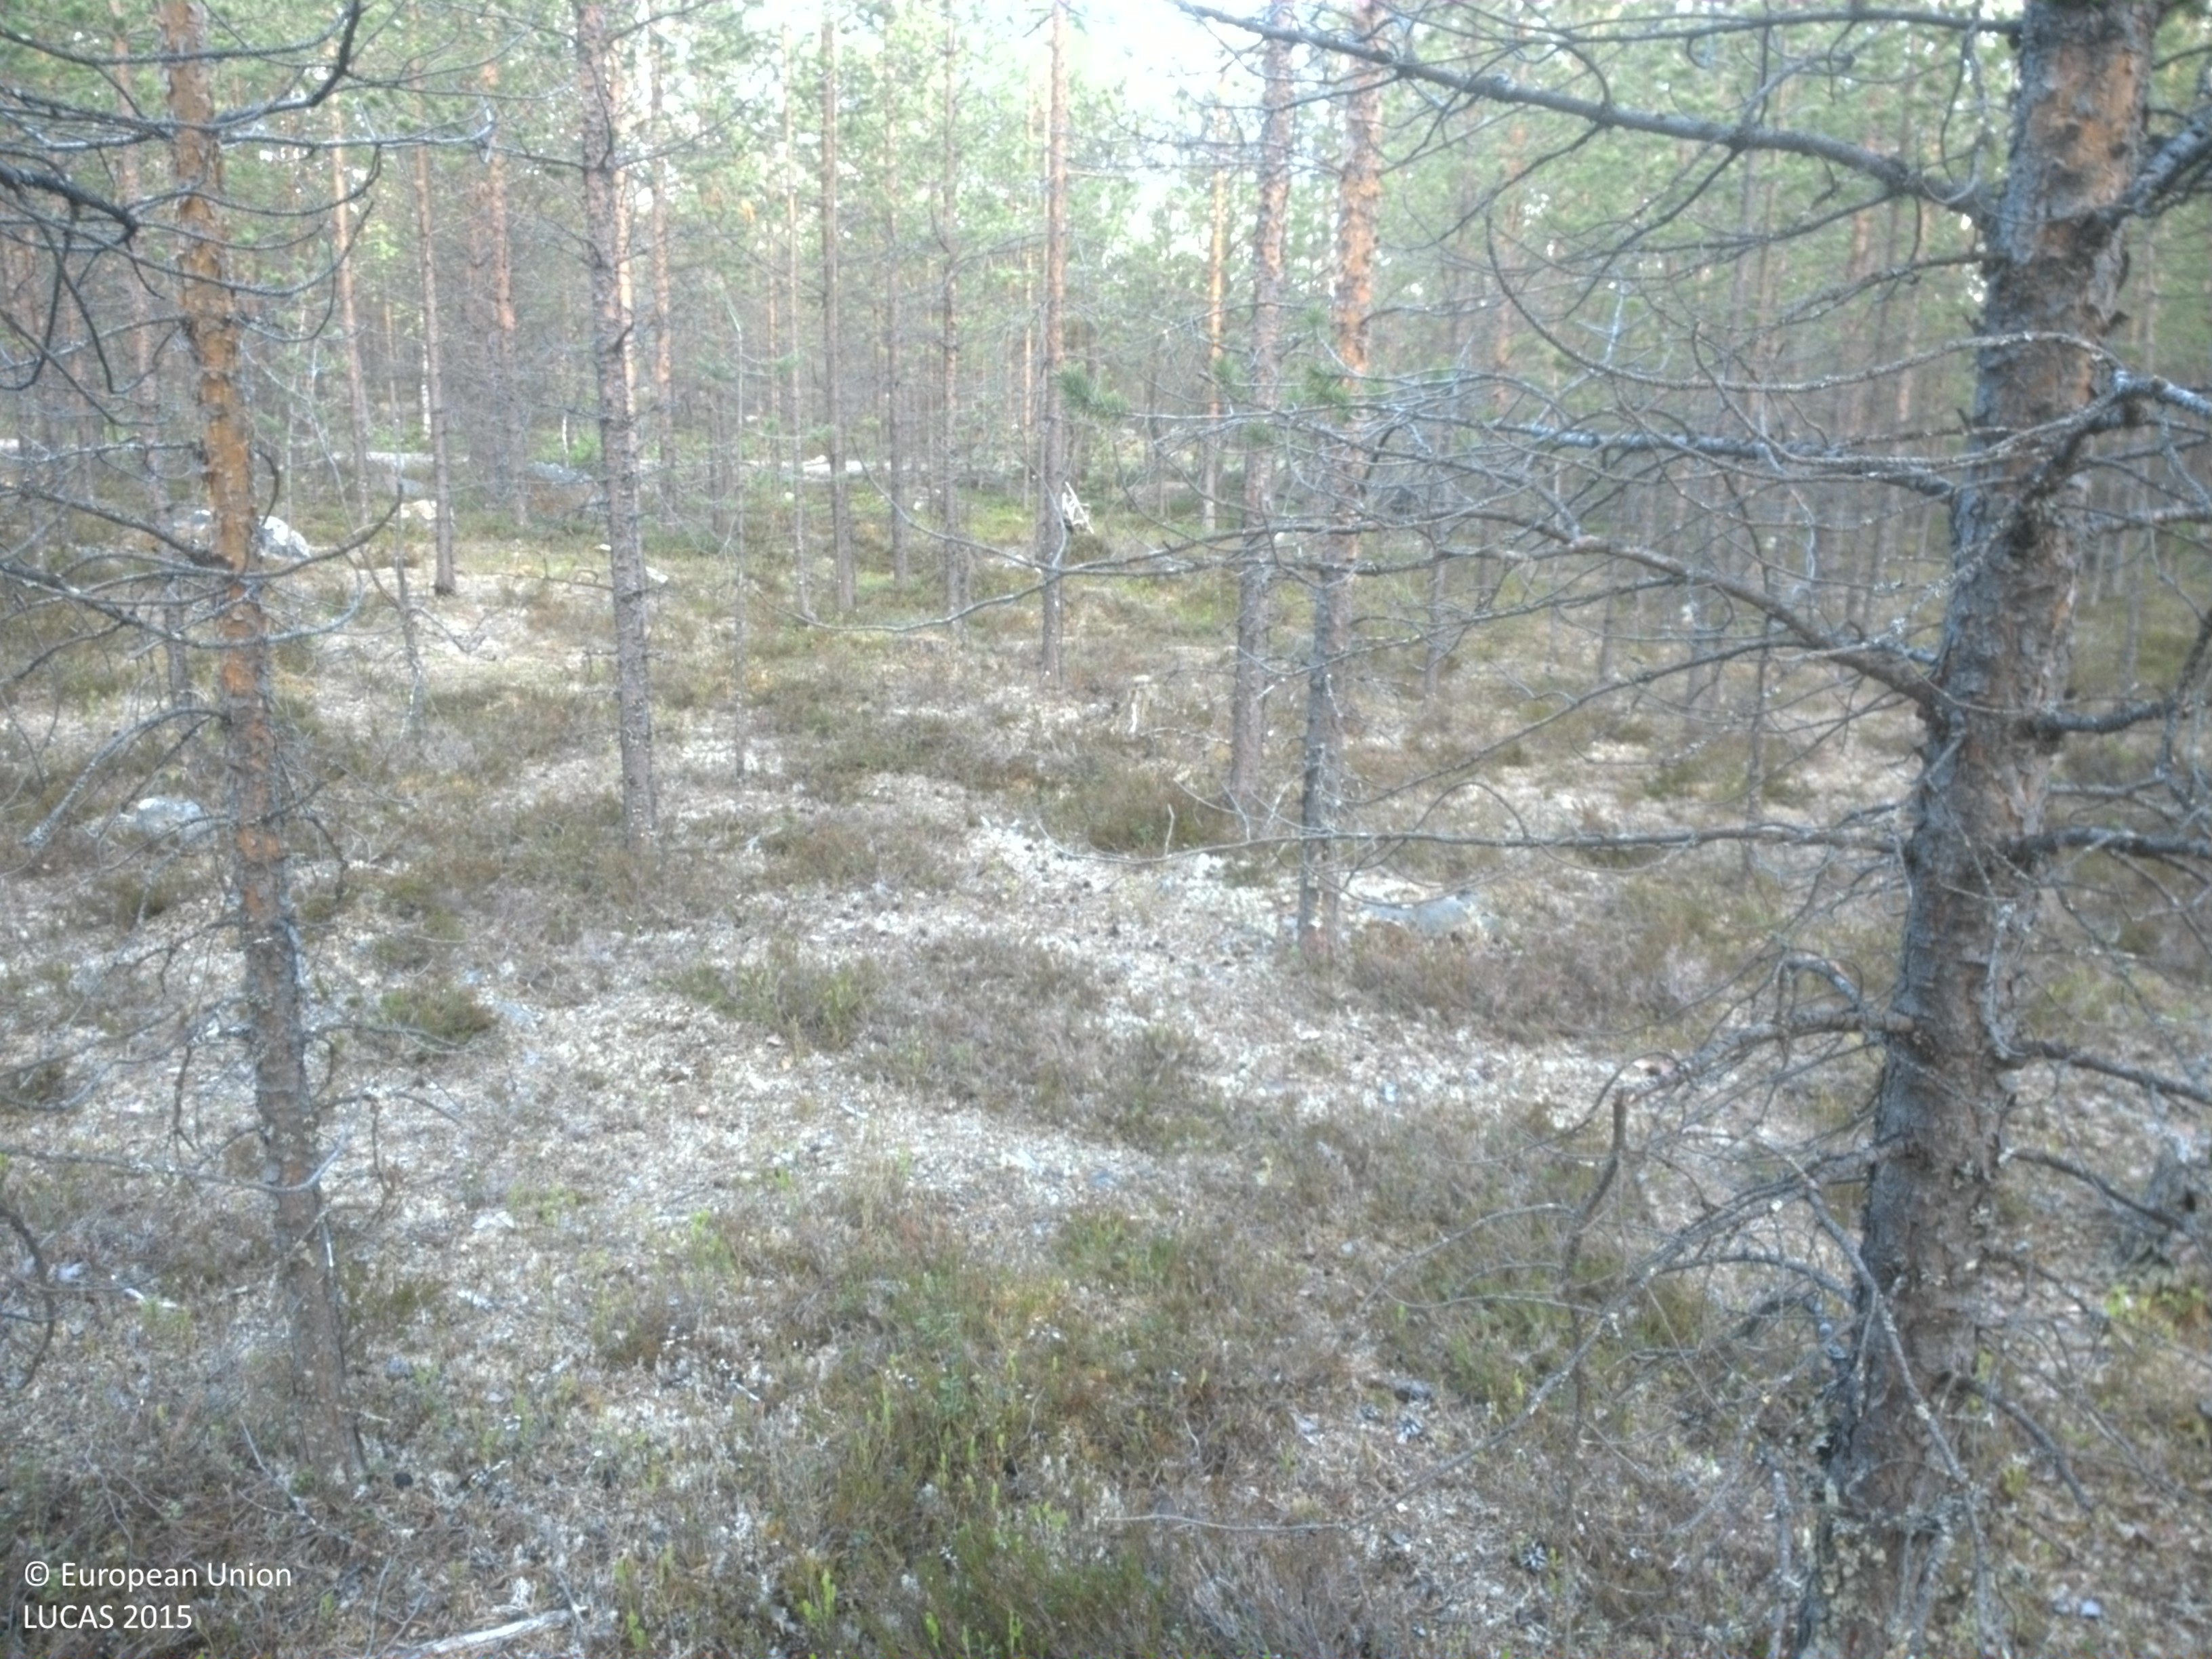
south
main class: Woodland
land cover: Pine dominated coniferous woodland
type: boreal forest
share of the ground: 25 - 50 %
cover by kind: shrubs 40 %, lichens and mosses 30 %, coniferous forest trees 25 %, unconsolidated bare surface 5 %
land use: Forestry
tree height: > 5 m
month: June
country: SE
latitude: 66.9029
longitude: 21.8618
